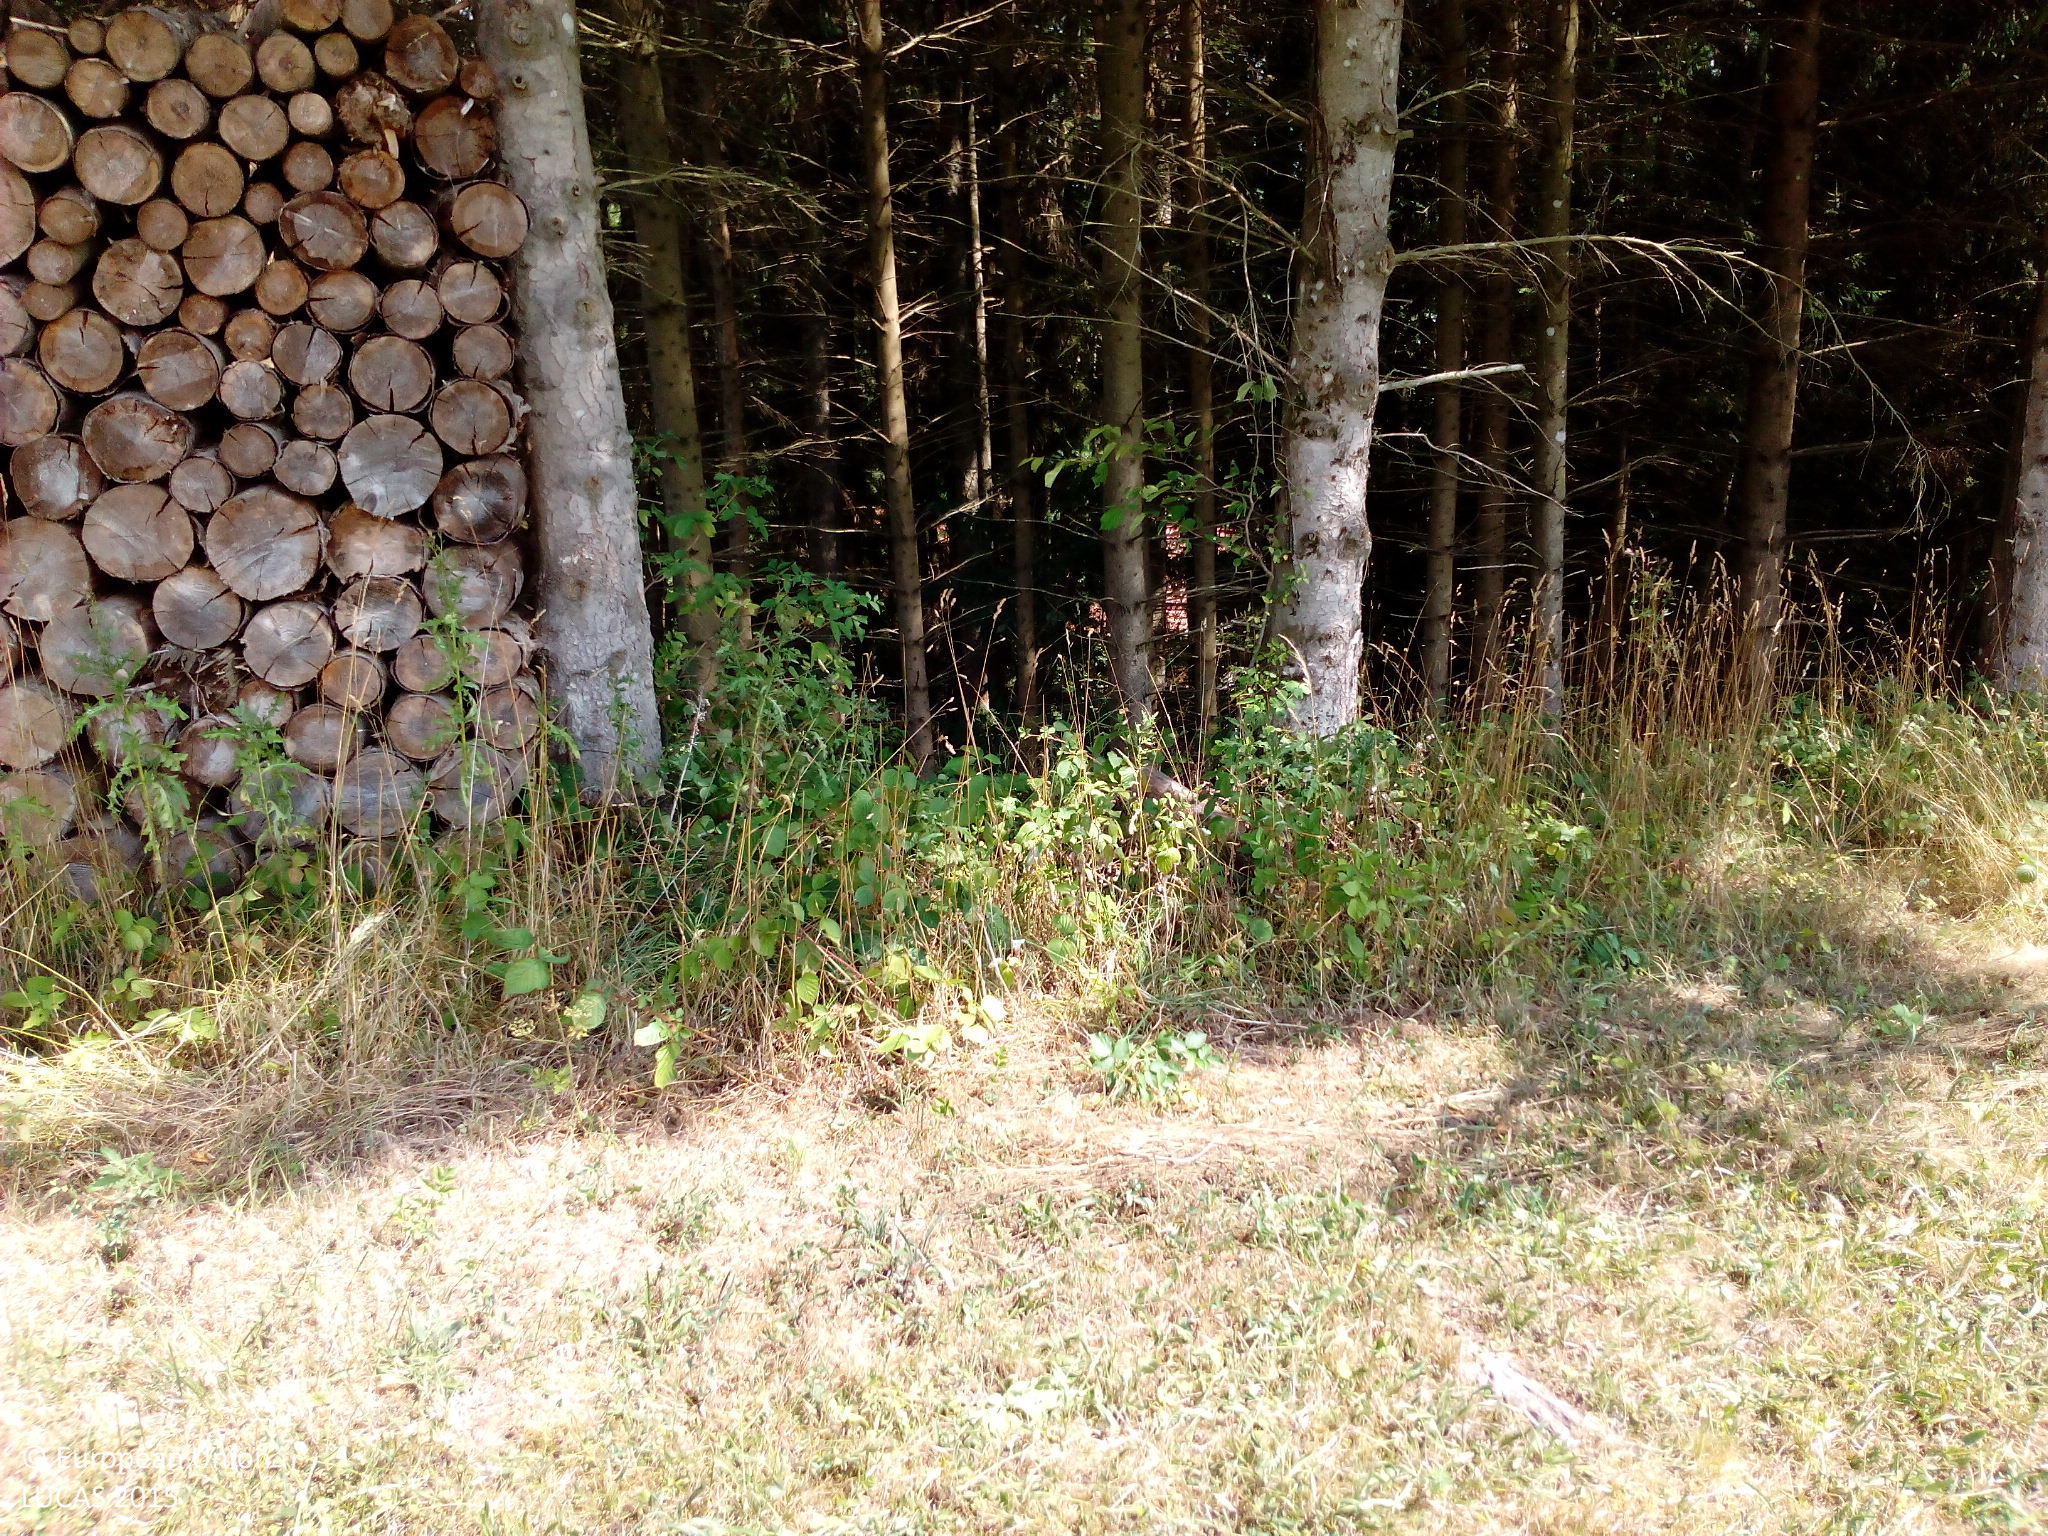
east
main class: Grassland
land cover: Grassland without tree/shrub cover
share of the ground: > 75 %
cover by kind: herbaceous plants 100 %
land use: Agriculture (excluding fallow land and kitchen gardens)
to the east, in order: Grassland without tree/shrub cover; Spruce dominated coniferous woodland; Rivers and streams; Spruce dominated coniferous woodland; Broadleaved woodland; Inland fresh running water; Broadleaved woodland; Artificial constructions in urban areas
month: August
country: DE
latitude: 47.6495
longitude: 8.1242
